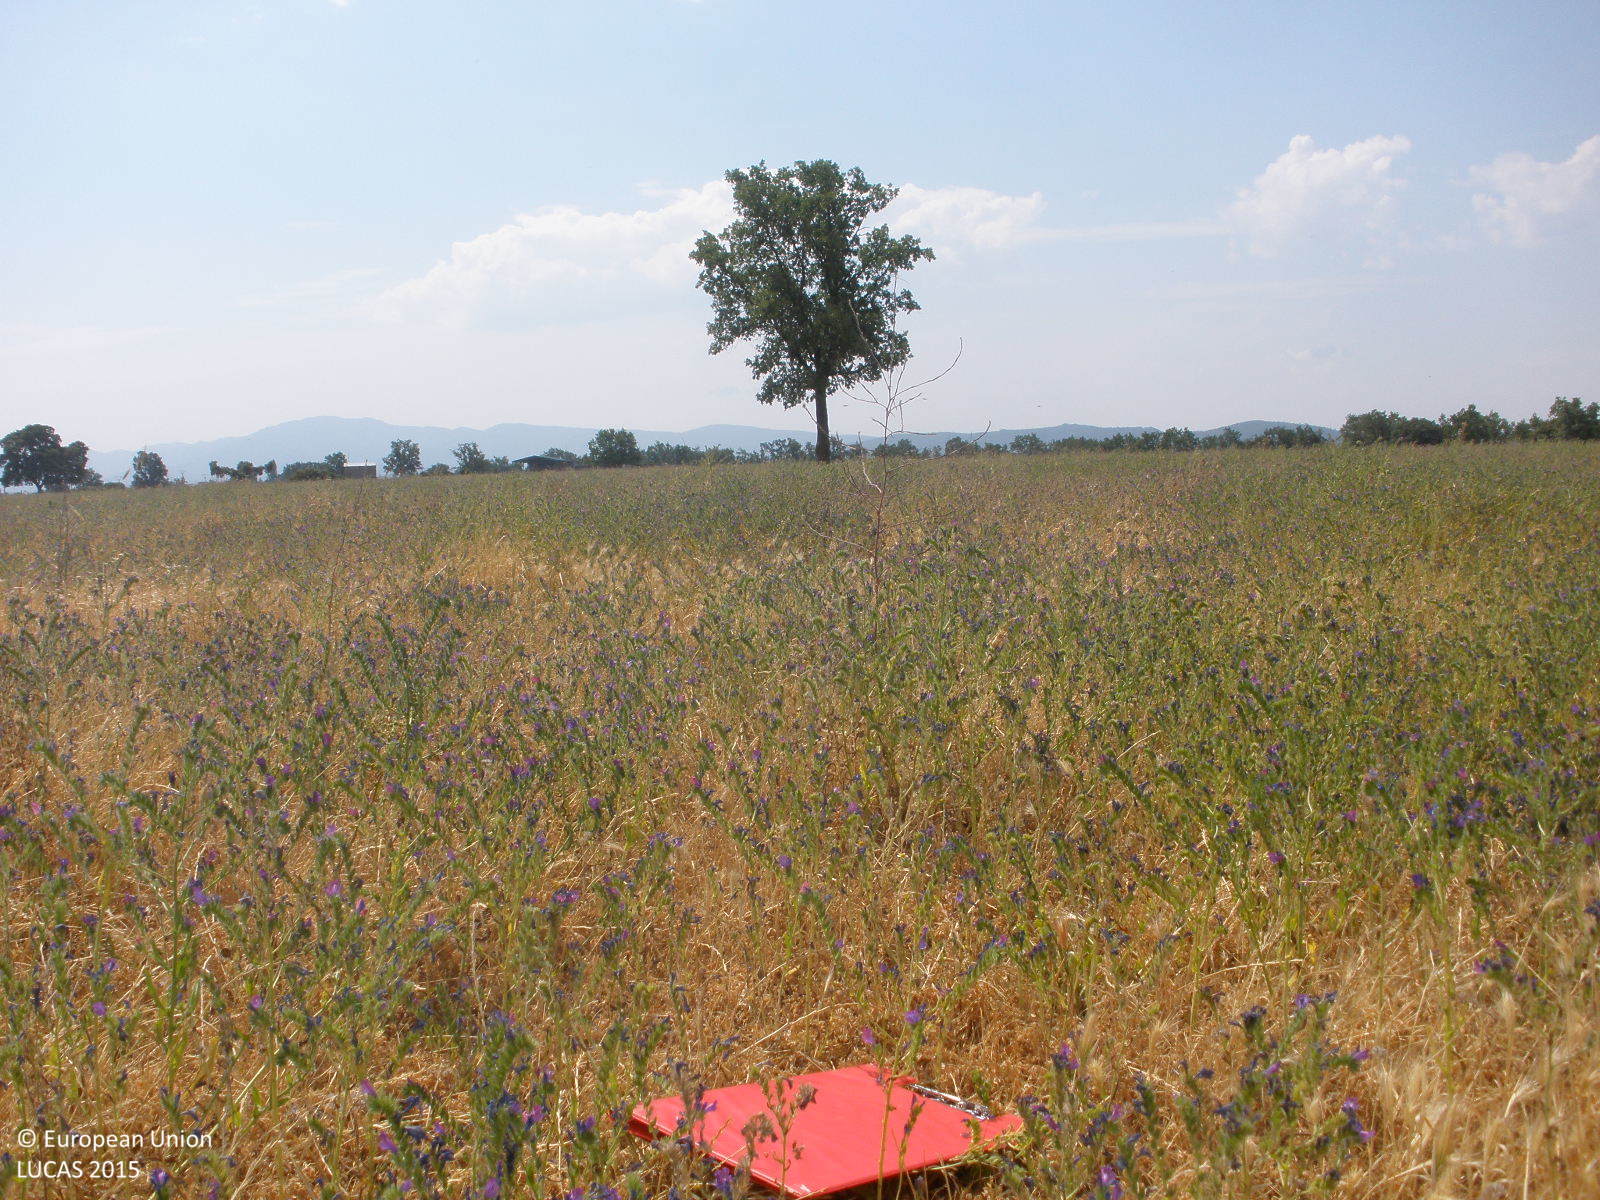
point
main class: Grassland
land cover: Grassland without tree/shrub cover
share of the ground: > 75 %
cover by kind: herbaceous plants 100 %
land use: Agriculture (excluding fallow land and kitchen gardens)
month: June
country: ES
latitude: 40.6314
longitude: -6.3668
